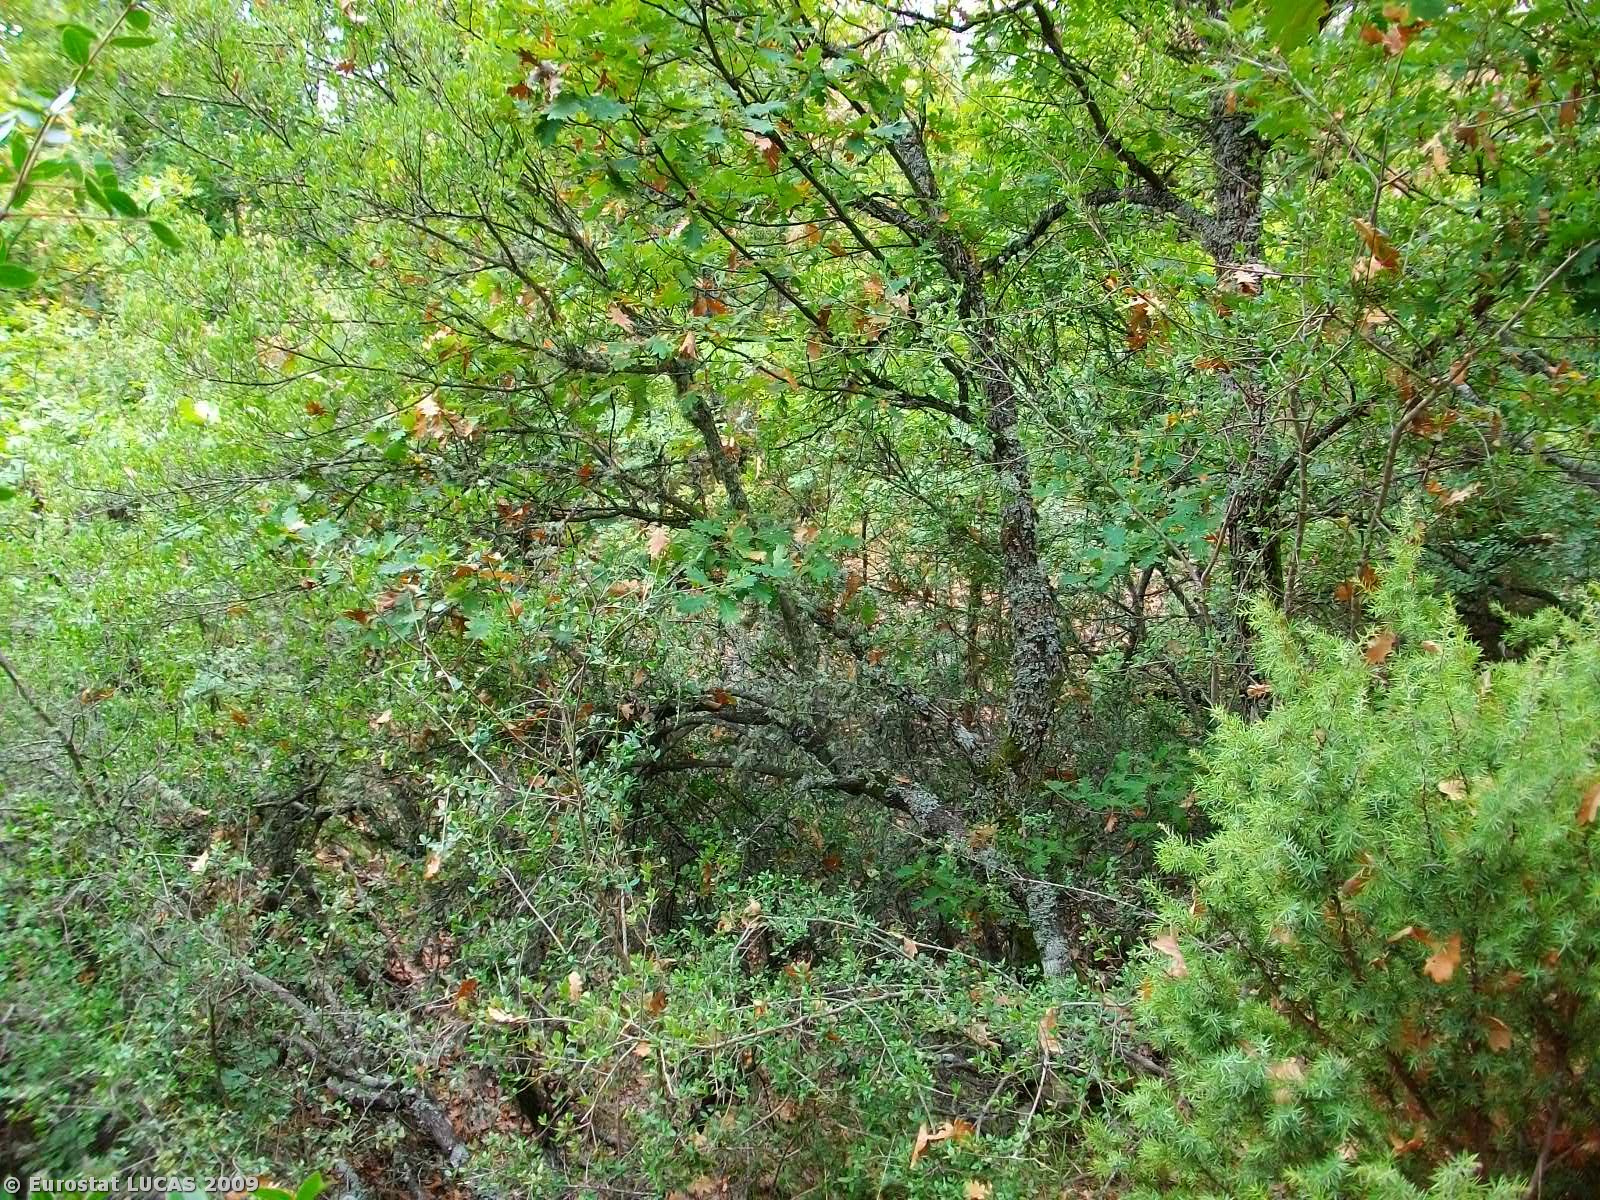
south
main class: Woodland
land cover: Broadleaved woodland
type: thermophilous deciduous forest
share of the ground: > 75 %
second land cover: Grassland with sparse tree/shrub cover
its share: 50 - 75 %
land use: Forestry
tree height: > 5 m
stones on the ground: 10 - 25 %
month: September
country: GR
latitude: 41.2691
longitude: 26.2935
